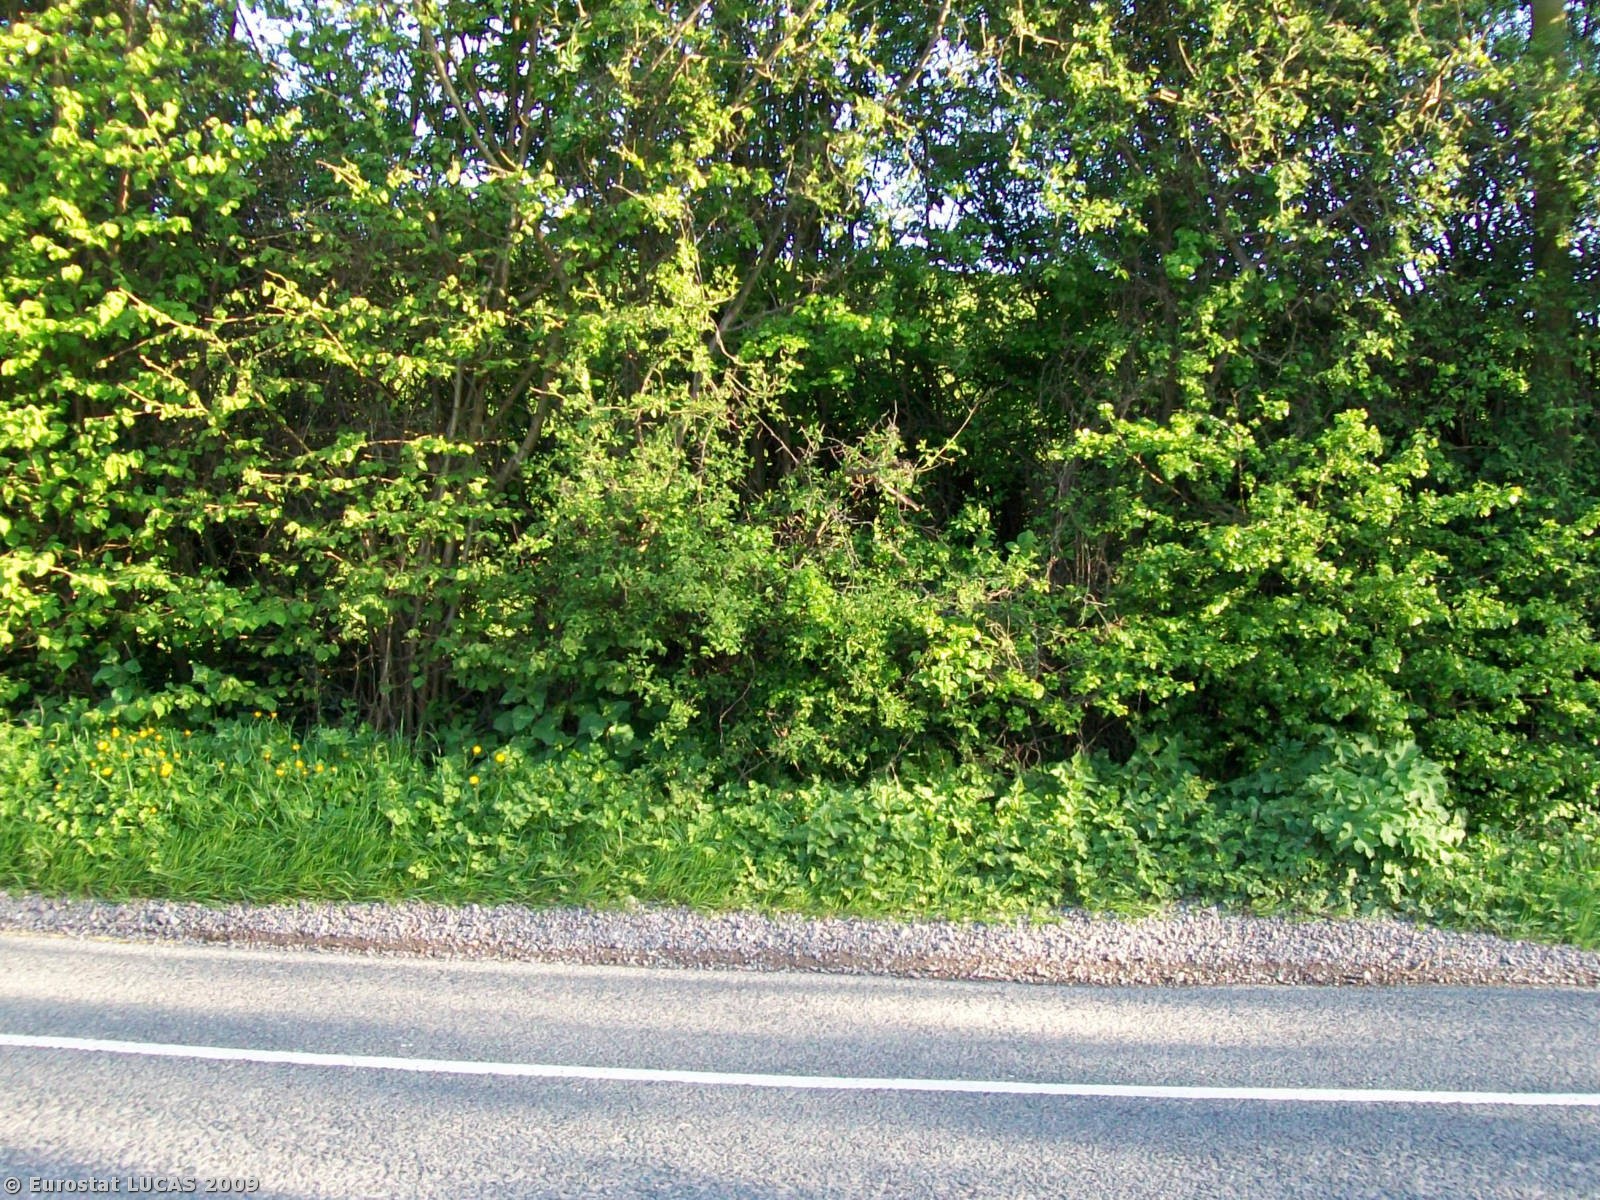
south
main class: Grassland
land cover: Grassland without tree/shrub cover
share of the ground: > 75 %
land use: Agriculture (excluding fallow land and kitchen gardens)
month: May
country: IE
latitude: 52.0692
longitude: -8.2603
